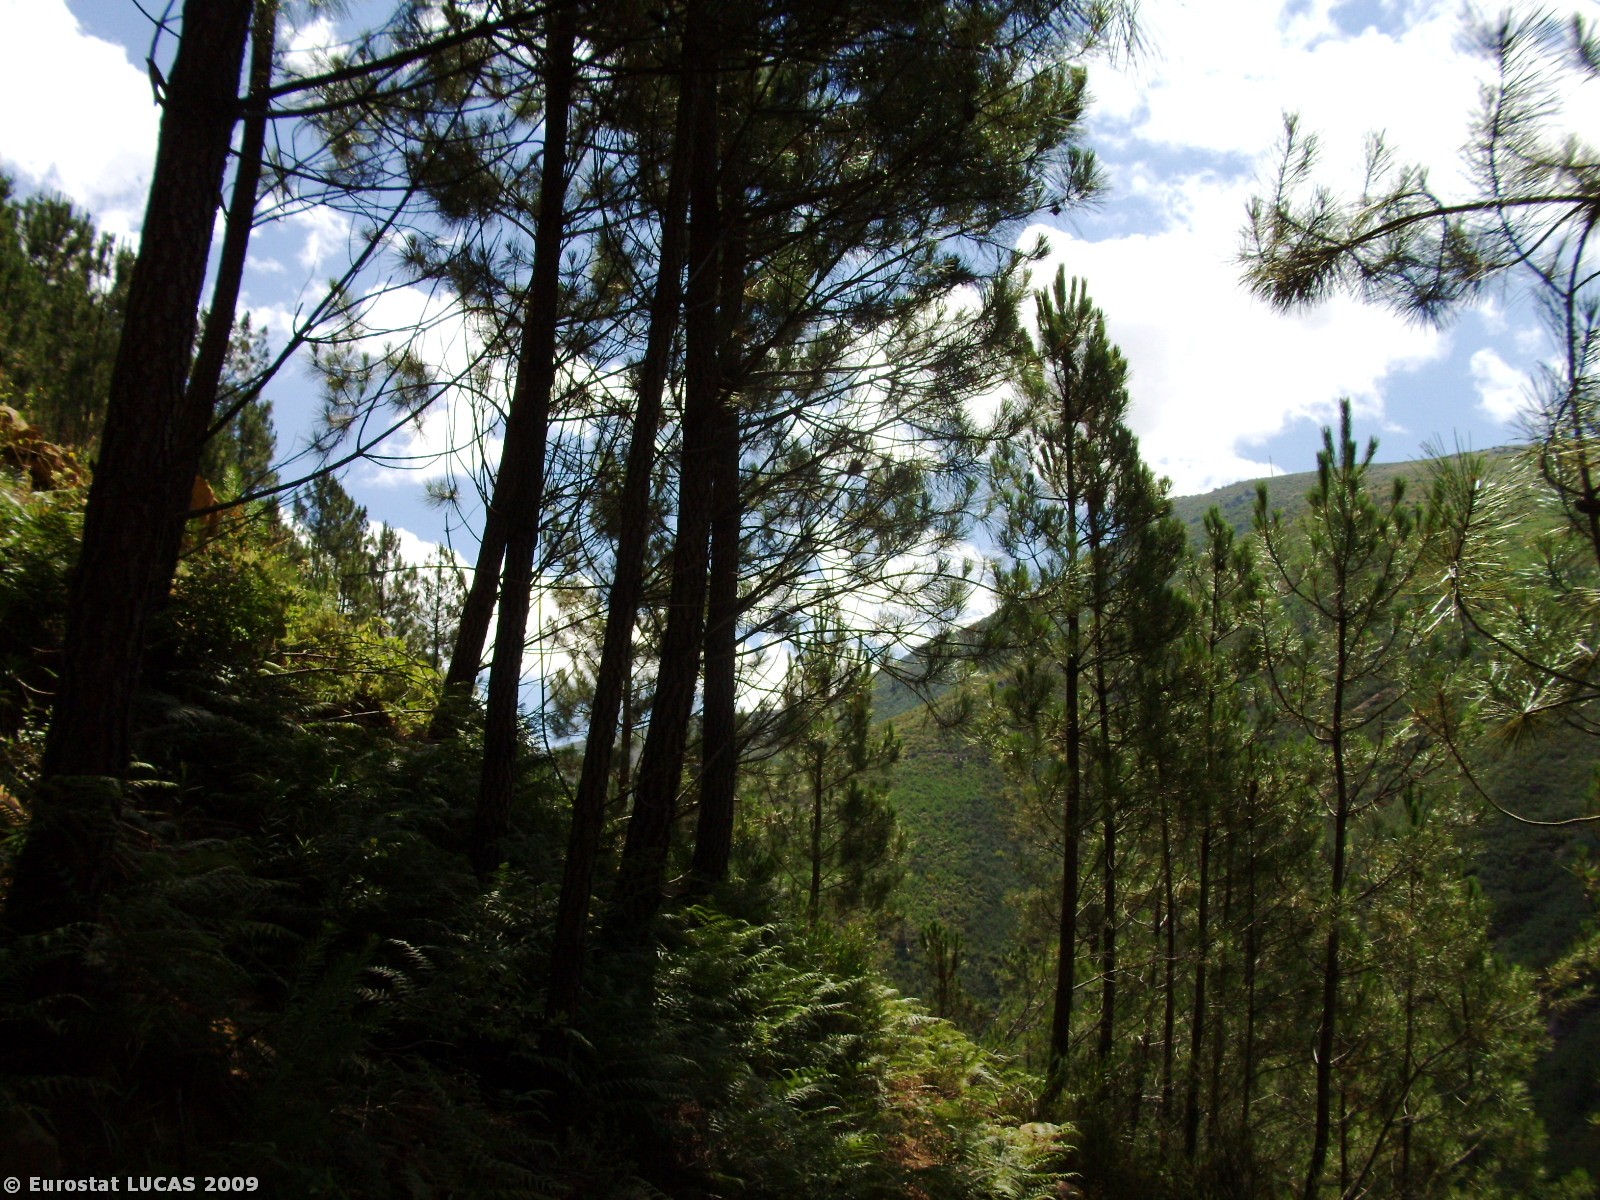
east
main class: Woodland
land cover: Coniferous woodland
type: coniferous forest of the mediterranean region
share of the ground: 50 - 75 %
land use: Forestry
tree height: > 5 m
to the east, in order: Coniferous woodland; Tracks; Coniferous woodland; Rivers and streams; Coniferous woodland
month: June
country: PT
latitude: 40.3183
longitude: -7.7305
